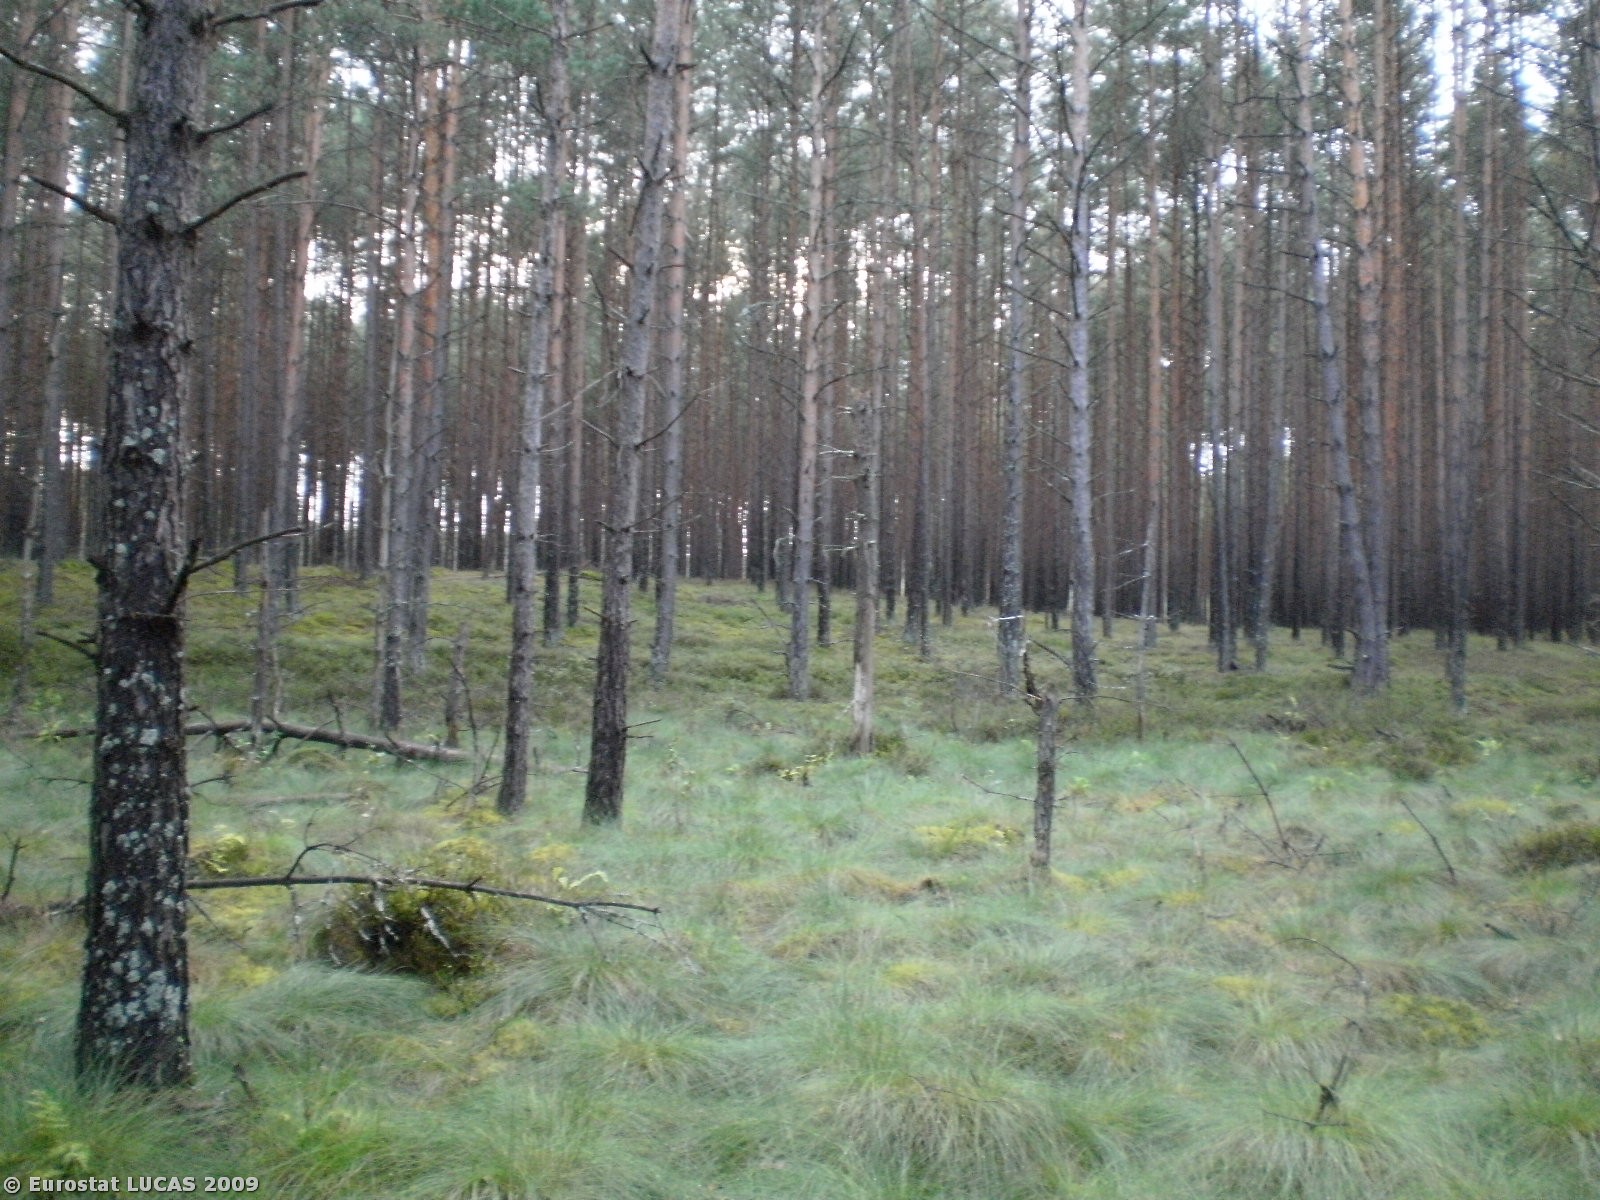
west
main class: Woodland
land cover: Coniferous woodland
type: hemiboreal forest and nemoral coniferous forest and mixed broadleaved-coniferous forest
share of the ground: > 75 %
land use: Forestry
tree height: > 5 m
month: September
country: PL
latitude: 53.7863
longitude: 17.7384
